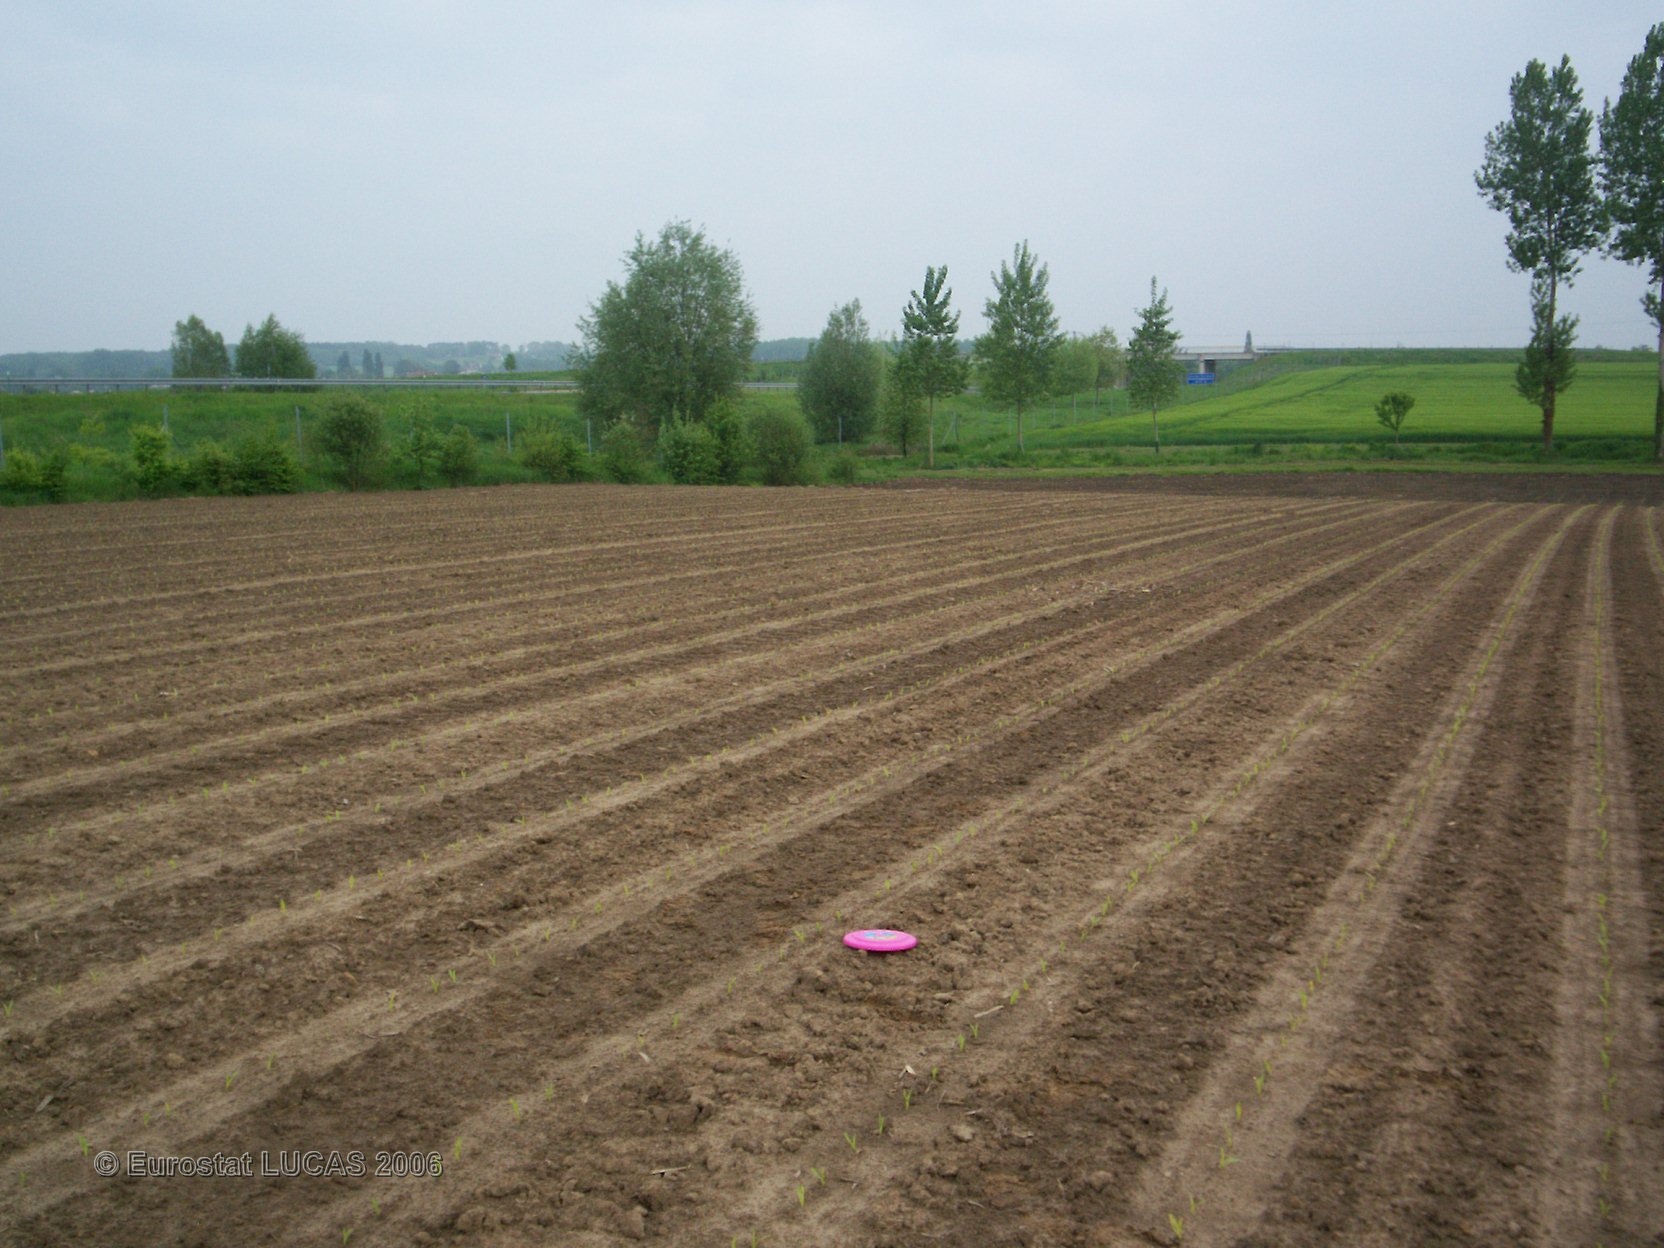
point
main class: Cropland
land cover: Maize
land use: Agriculture (excluding fallow land and kitchen gardens)
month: May
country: FR
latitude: 47.9039
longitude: 0.3031
